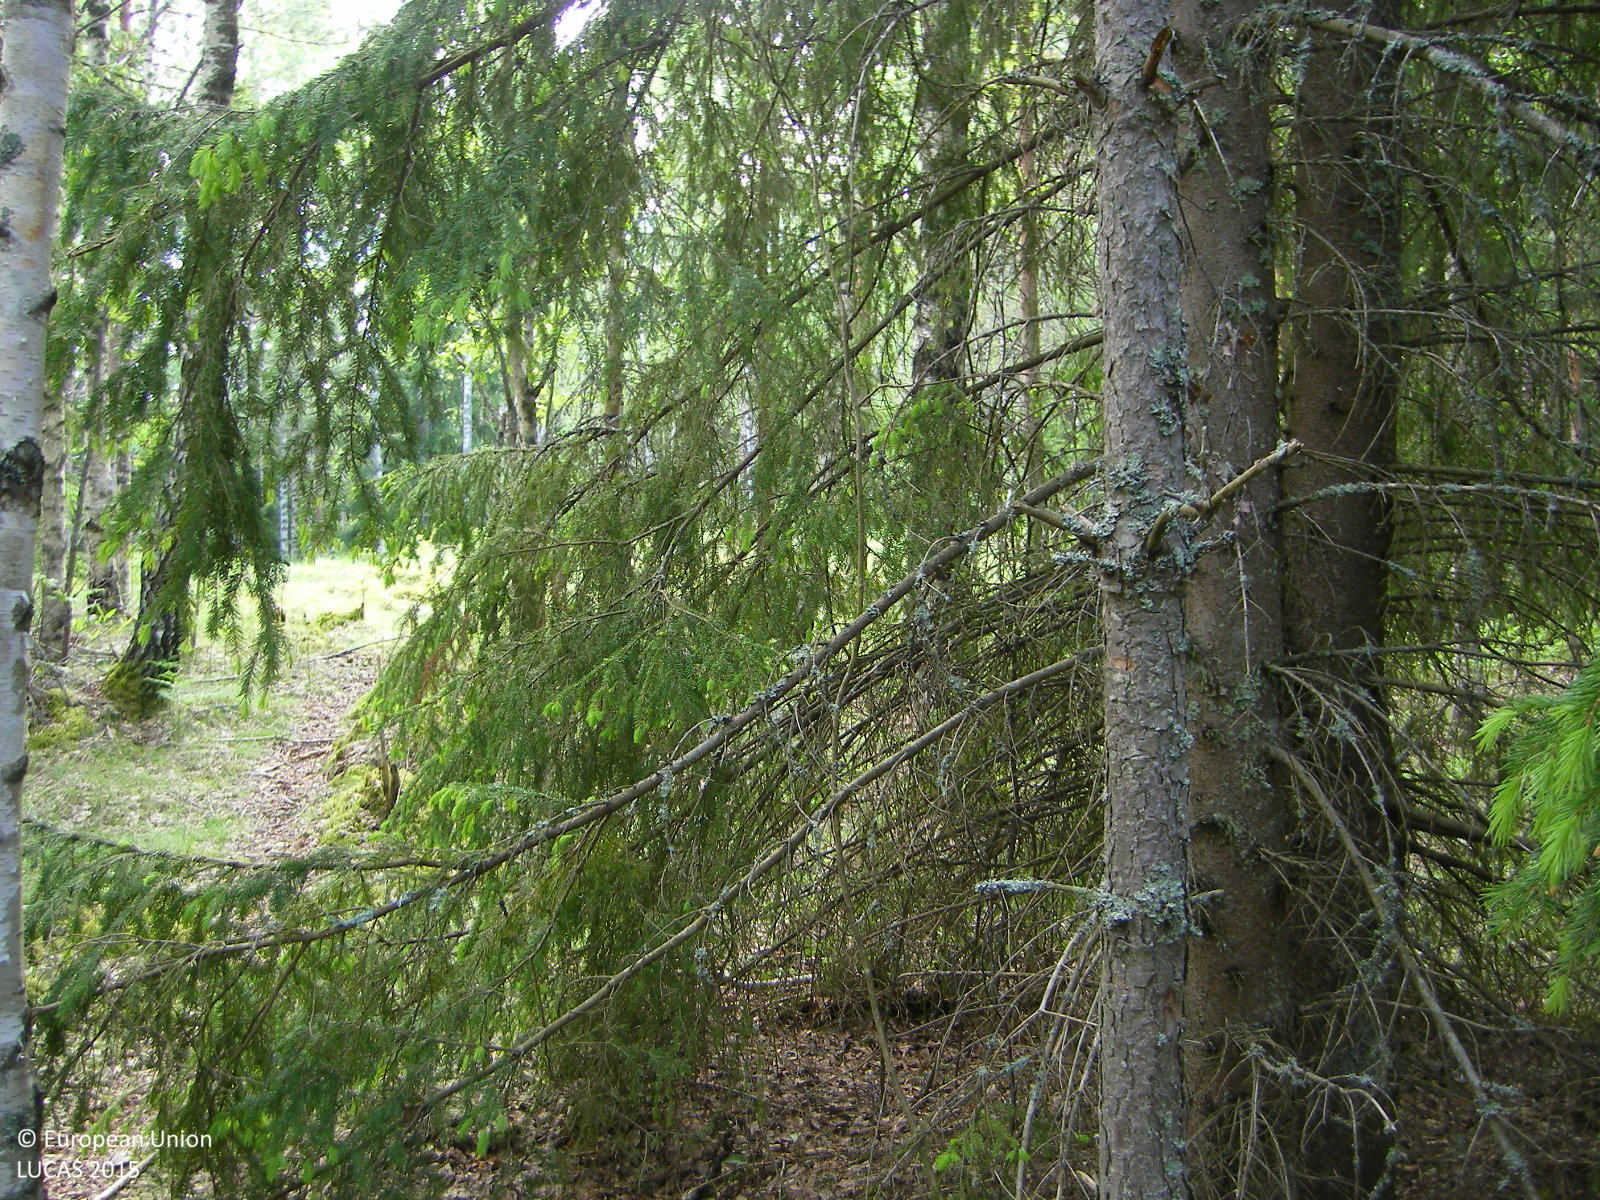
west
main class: Woodland
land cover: Spruce dominated mixed woodland
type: boreal forest
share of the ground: > 75 %
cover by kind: broadleaved forest trees 60 %, coniferous forest trees 30 %, herbaceous plants 5 %, lichens and mosses 5 %
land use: Forestry
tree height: > 5 m
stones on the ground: < 10 %
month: June
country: FI
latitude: 60.1907
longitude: 24.5550
